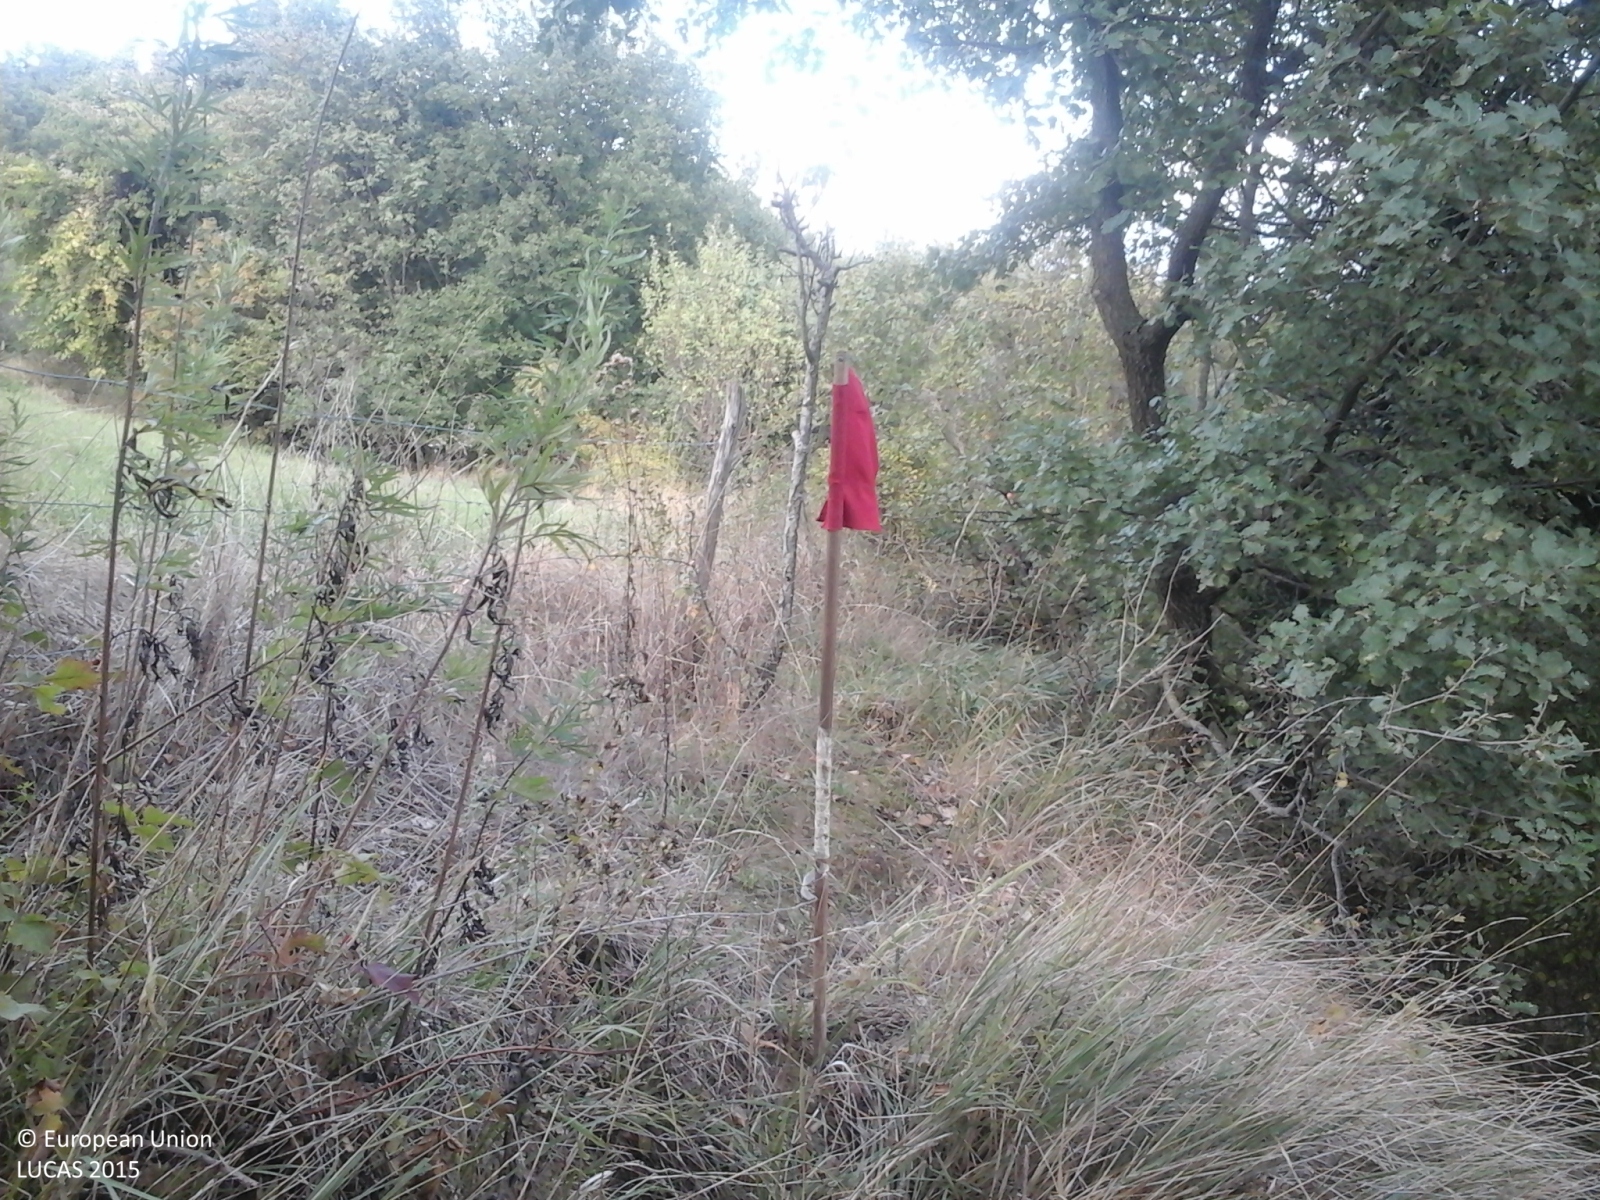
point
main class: Woodland
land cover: Broadleaved woodland
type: thermophilous deciduous forest
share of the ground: > 75 %
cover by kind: broadleaved forest trees 85 %, herbaceous plants 10 %, shrubs 5 %
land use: Semi-natural and natural areas not in use
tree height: > 5 m
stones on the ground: < 10 %
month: October
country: IT
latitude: 43.1978
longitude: 12.6385
